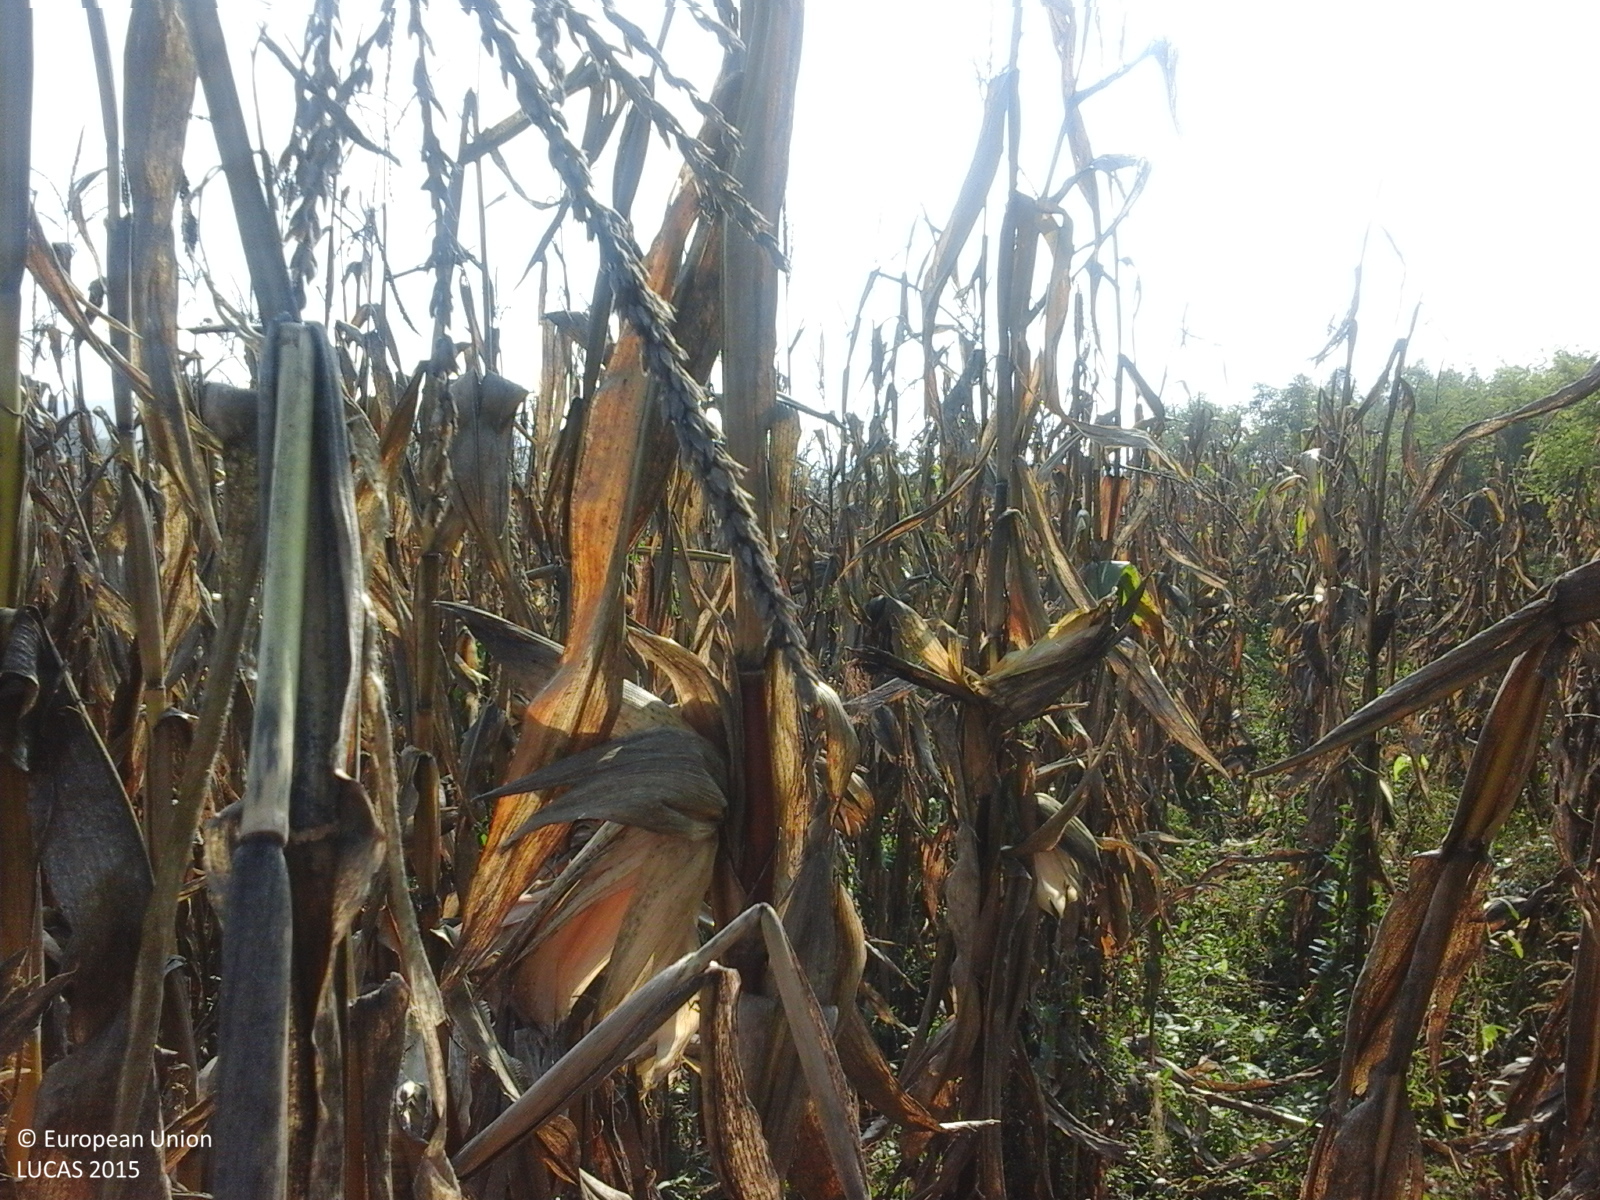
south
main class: Cropland
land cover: Maize
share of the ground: > 75 %
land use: Agriculture (excluding fallow land and kitchen gardens)
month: October
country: RO
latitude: 46.5588
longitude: 24.1285
